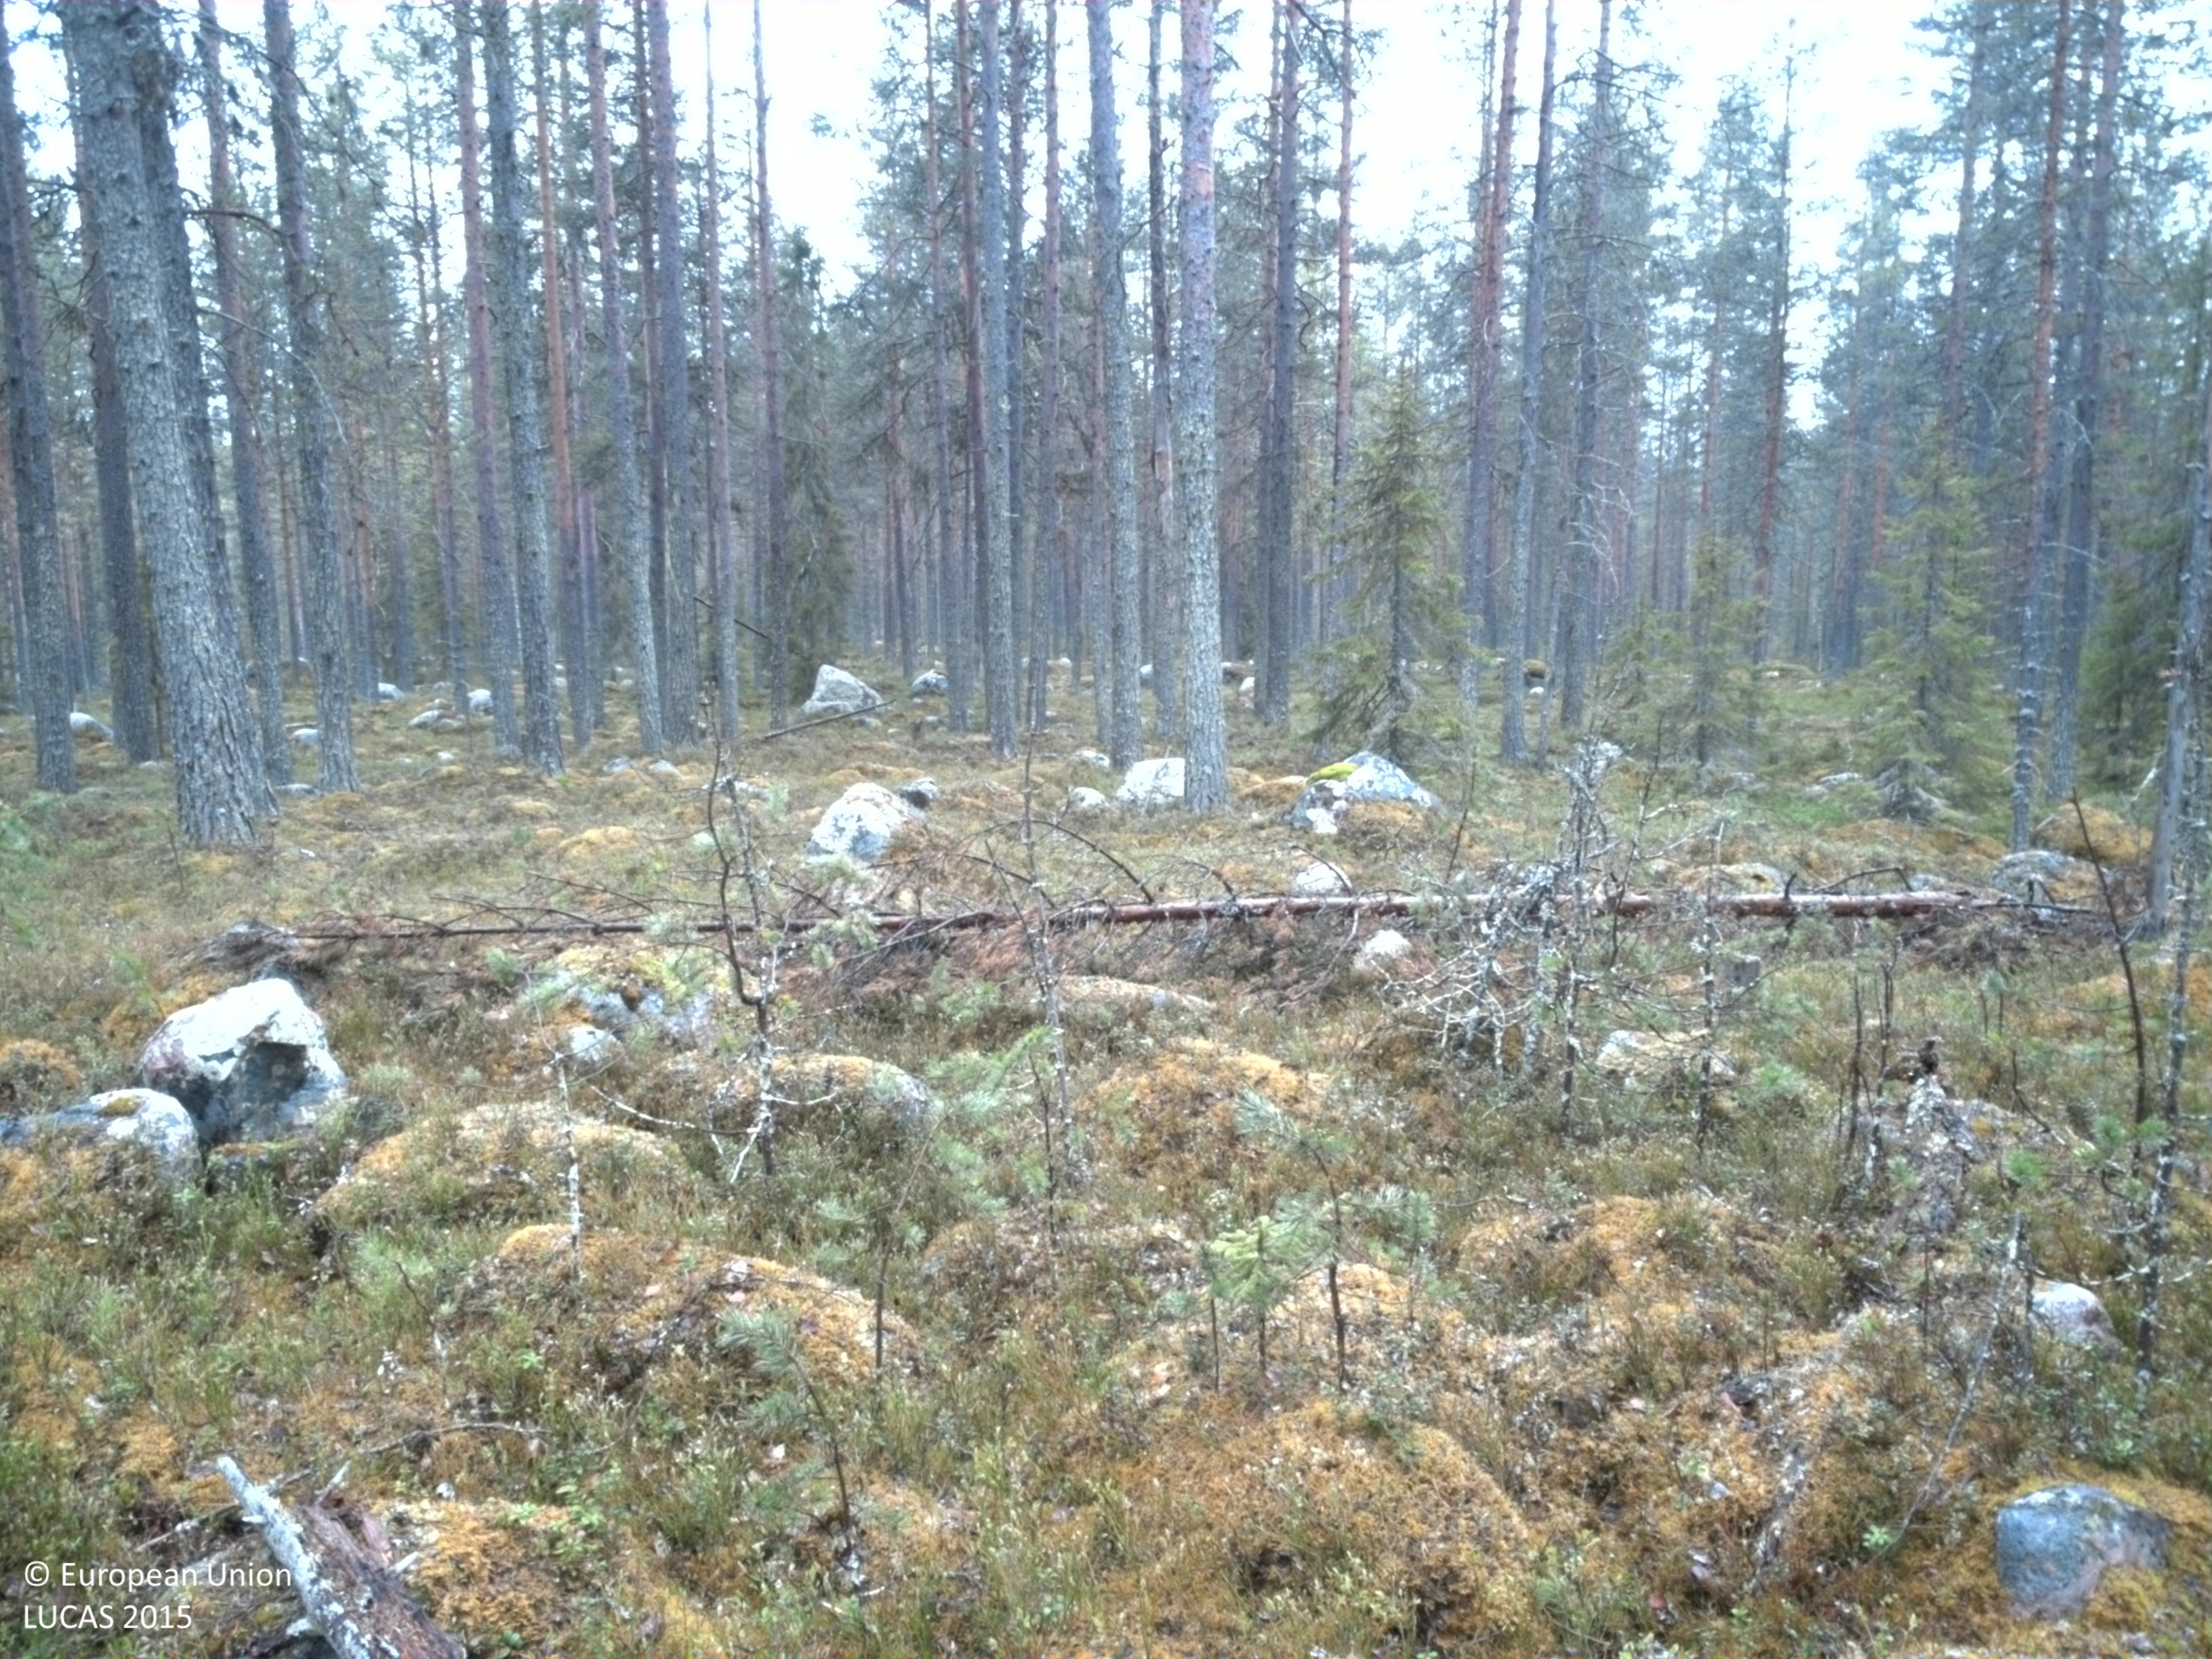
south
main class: Woodland
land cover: Pine dominated coniferous woodland
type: boreal forest
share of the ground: 50 - 75 %
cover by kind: coniferous forest trees 50 %, shrubs 25 %, consolidated bare surface 20 %, lichens and mosses 5 %
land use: Forestry
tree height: > 5 m
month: May
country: SE
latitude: 66.0837
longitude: 23.0034
